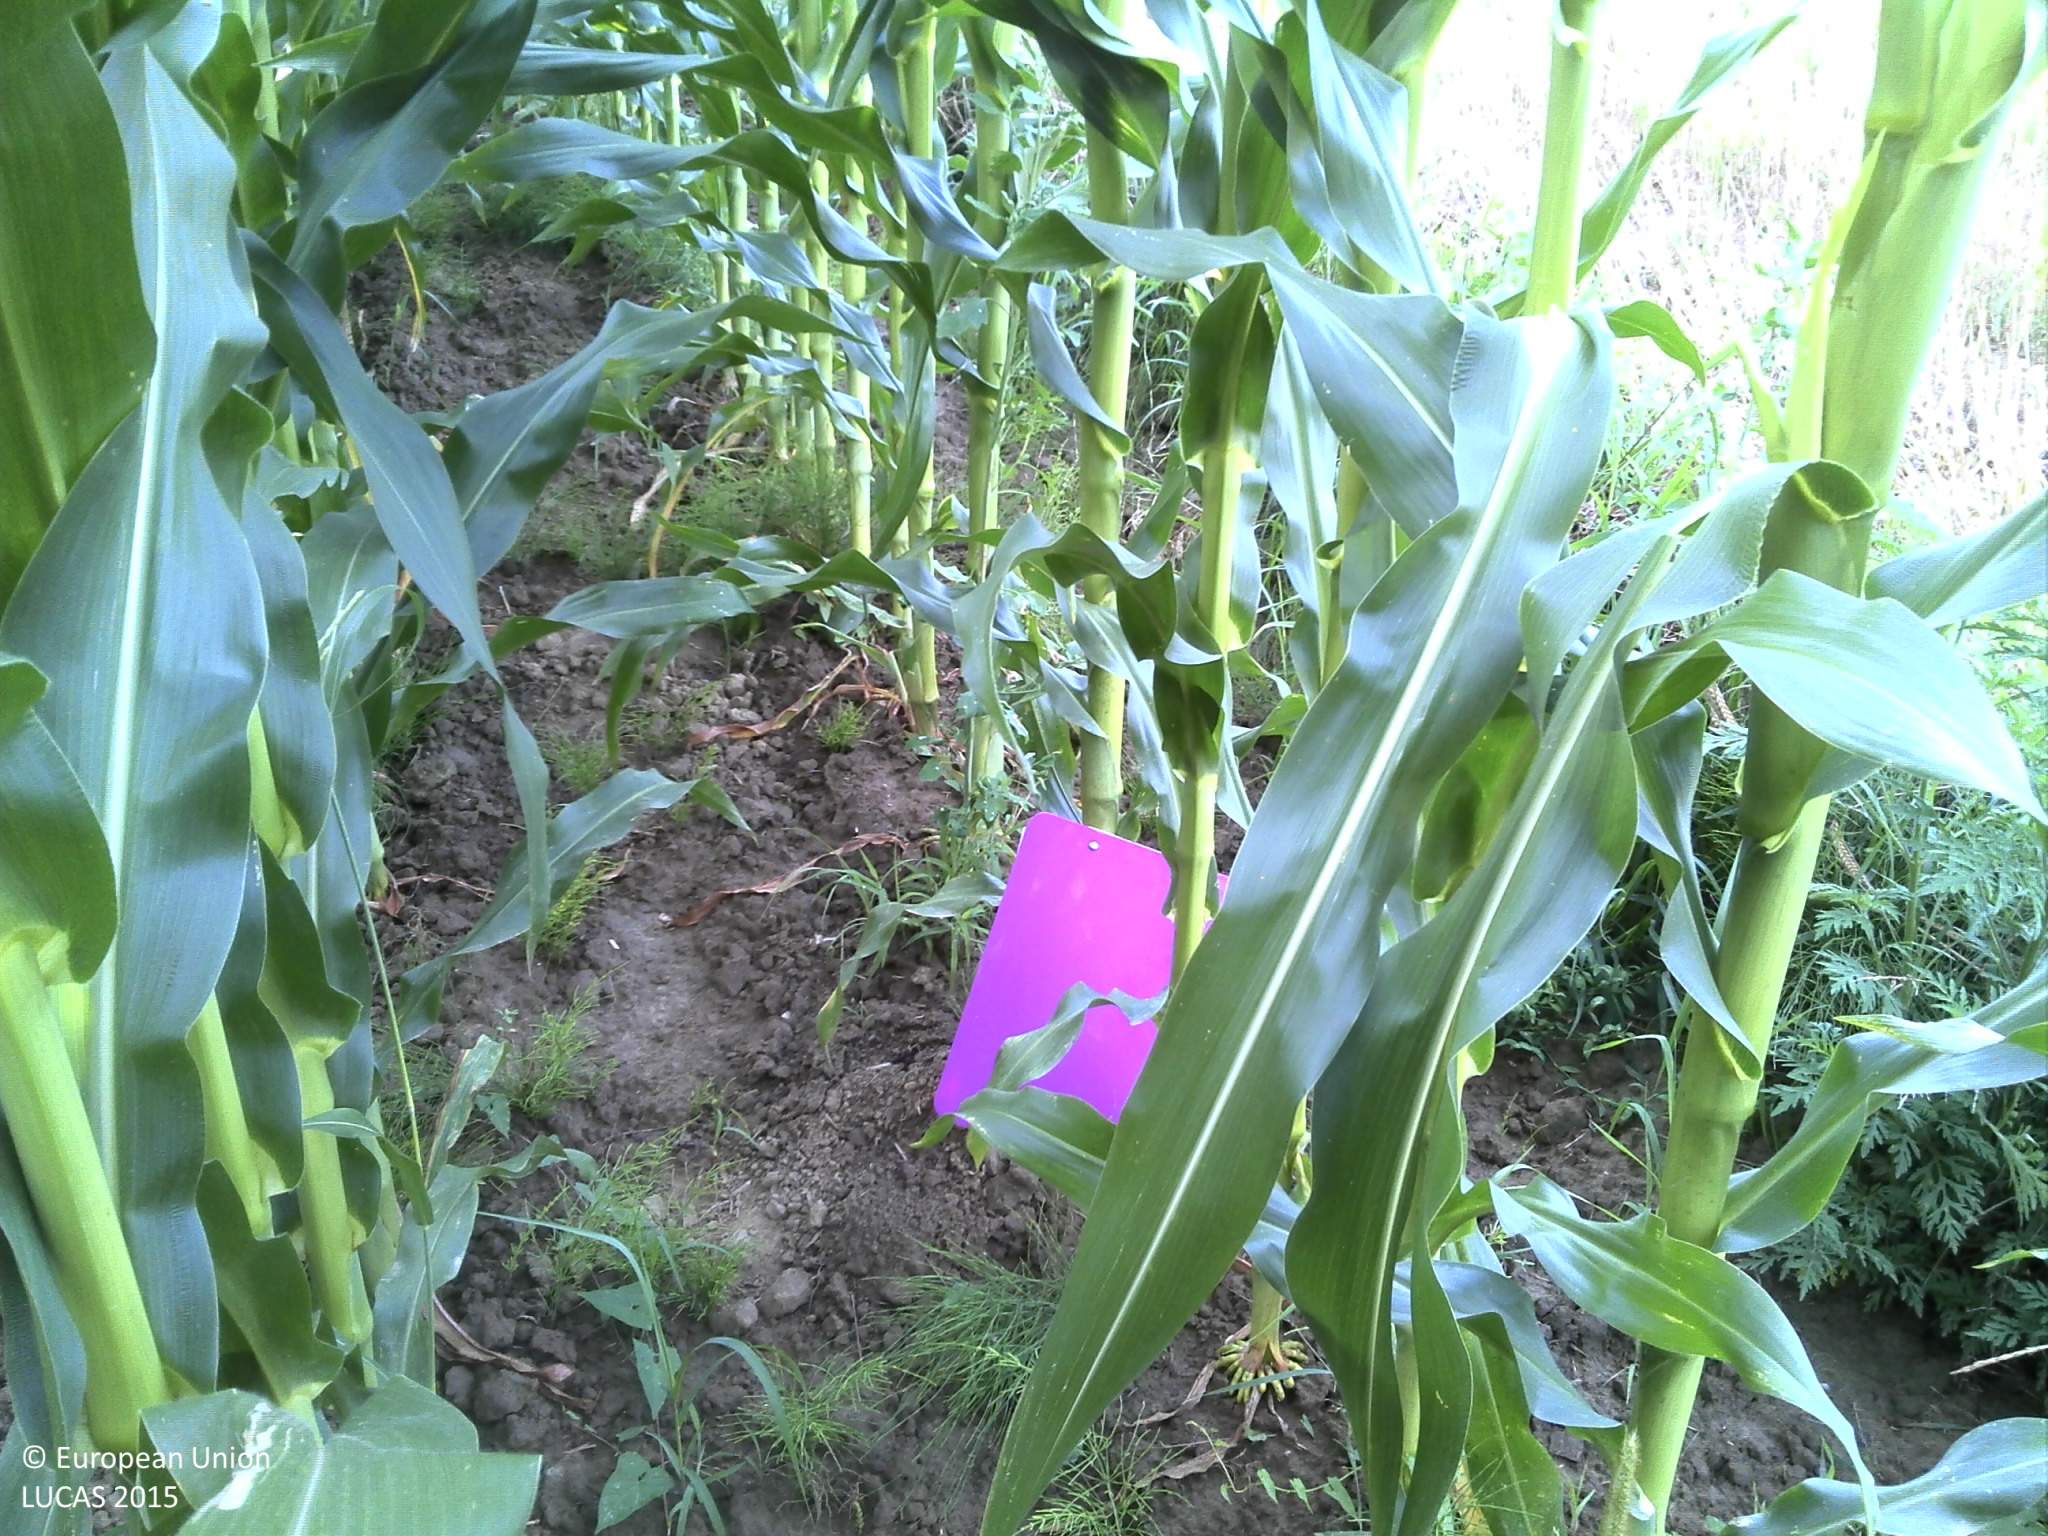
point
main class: Cropland
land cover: Maize
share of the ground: > 75 %
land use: Agriculture (excluding fallow land and kitchen gardens)
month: July
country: HR
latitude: 45.9115
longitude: 16.8978
